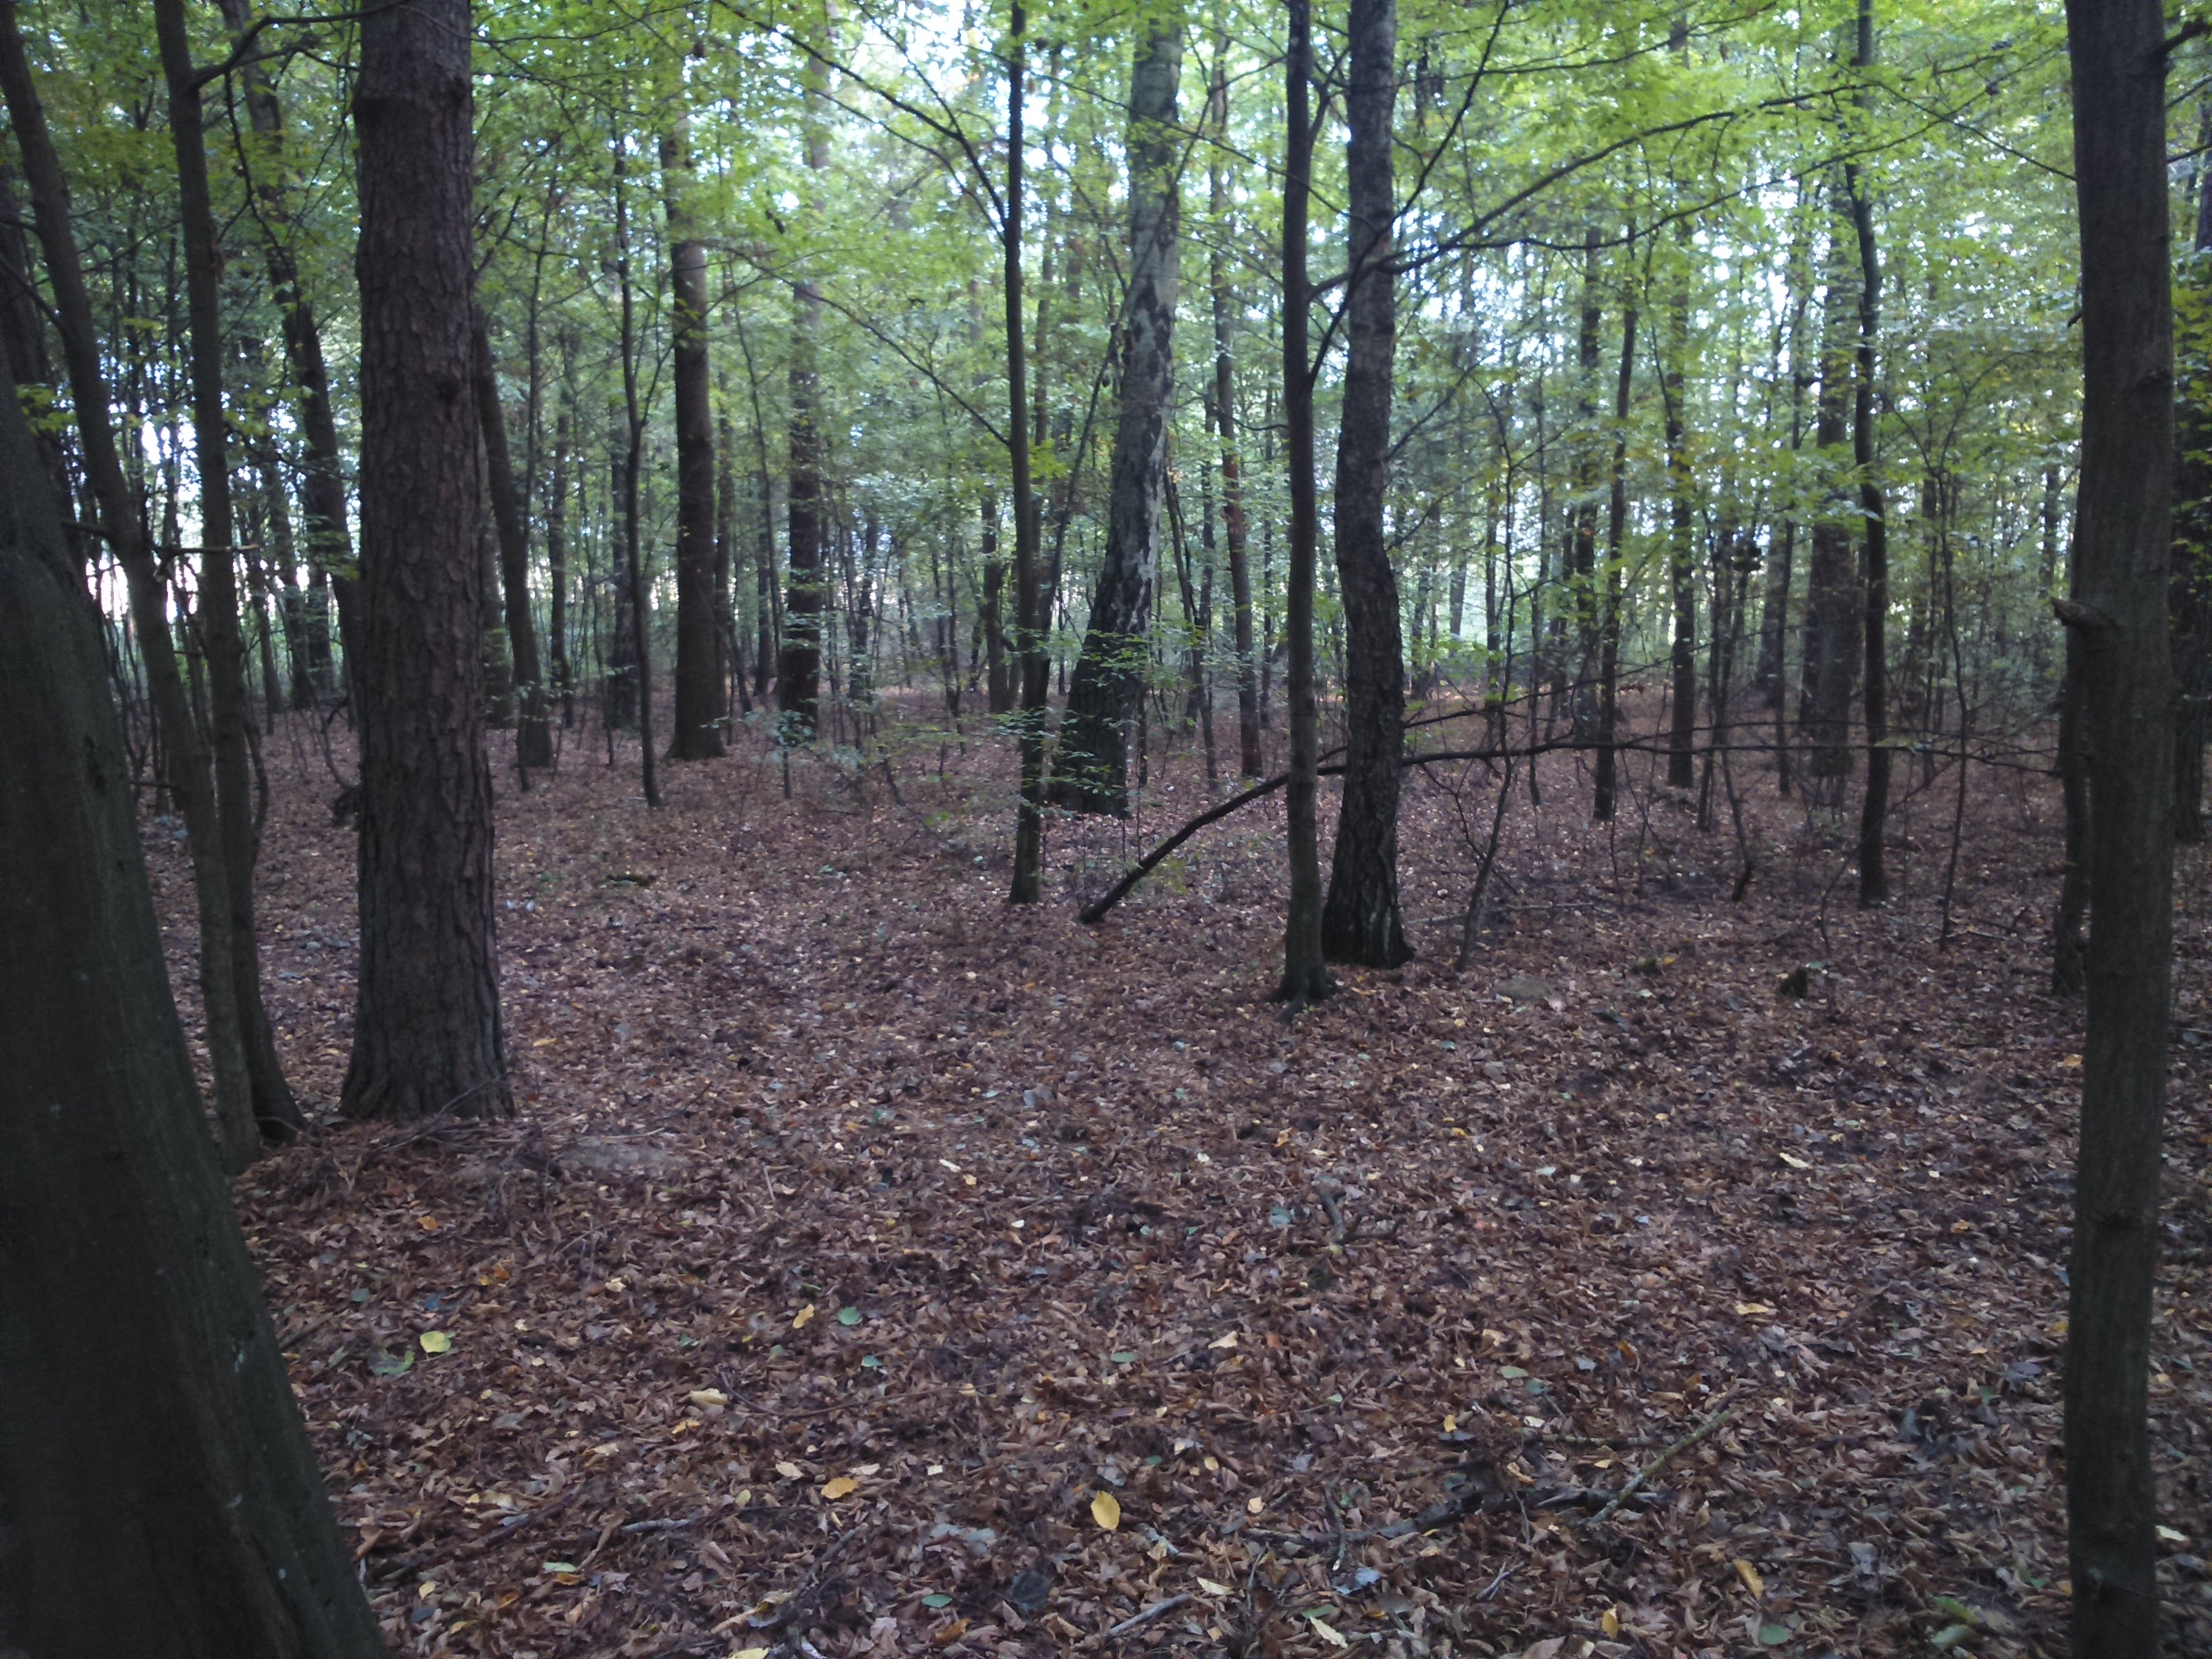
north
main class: Woodland
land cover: Broadleaved woodland
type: mesophytic deciduous forest
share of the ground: > 75 %
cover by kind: broadleaved forest trees 100 %
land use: Forestry
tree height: > 5 m
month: September
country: PL
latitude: 52.3427
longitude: 21.8725
